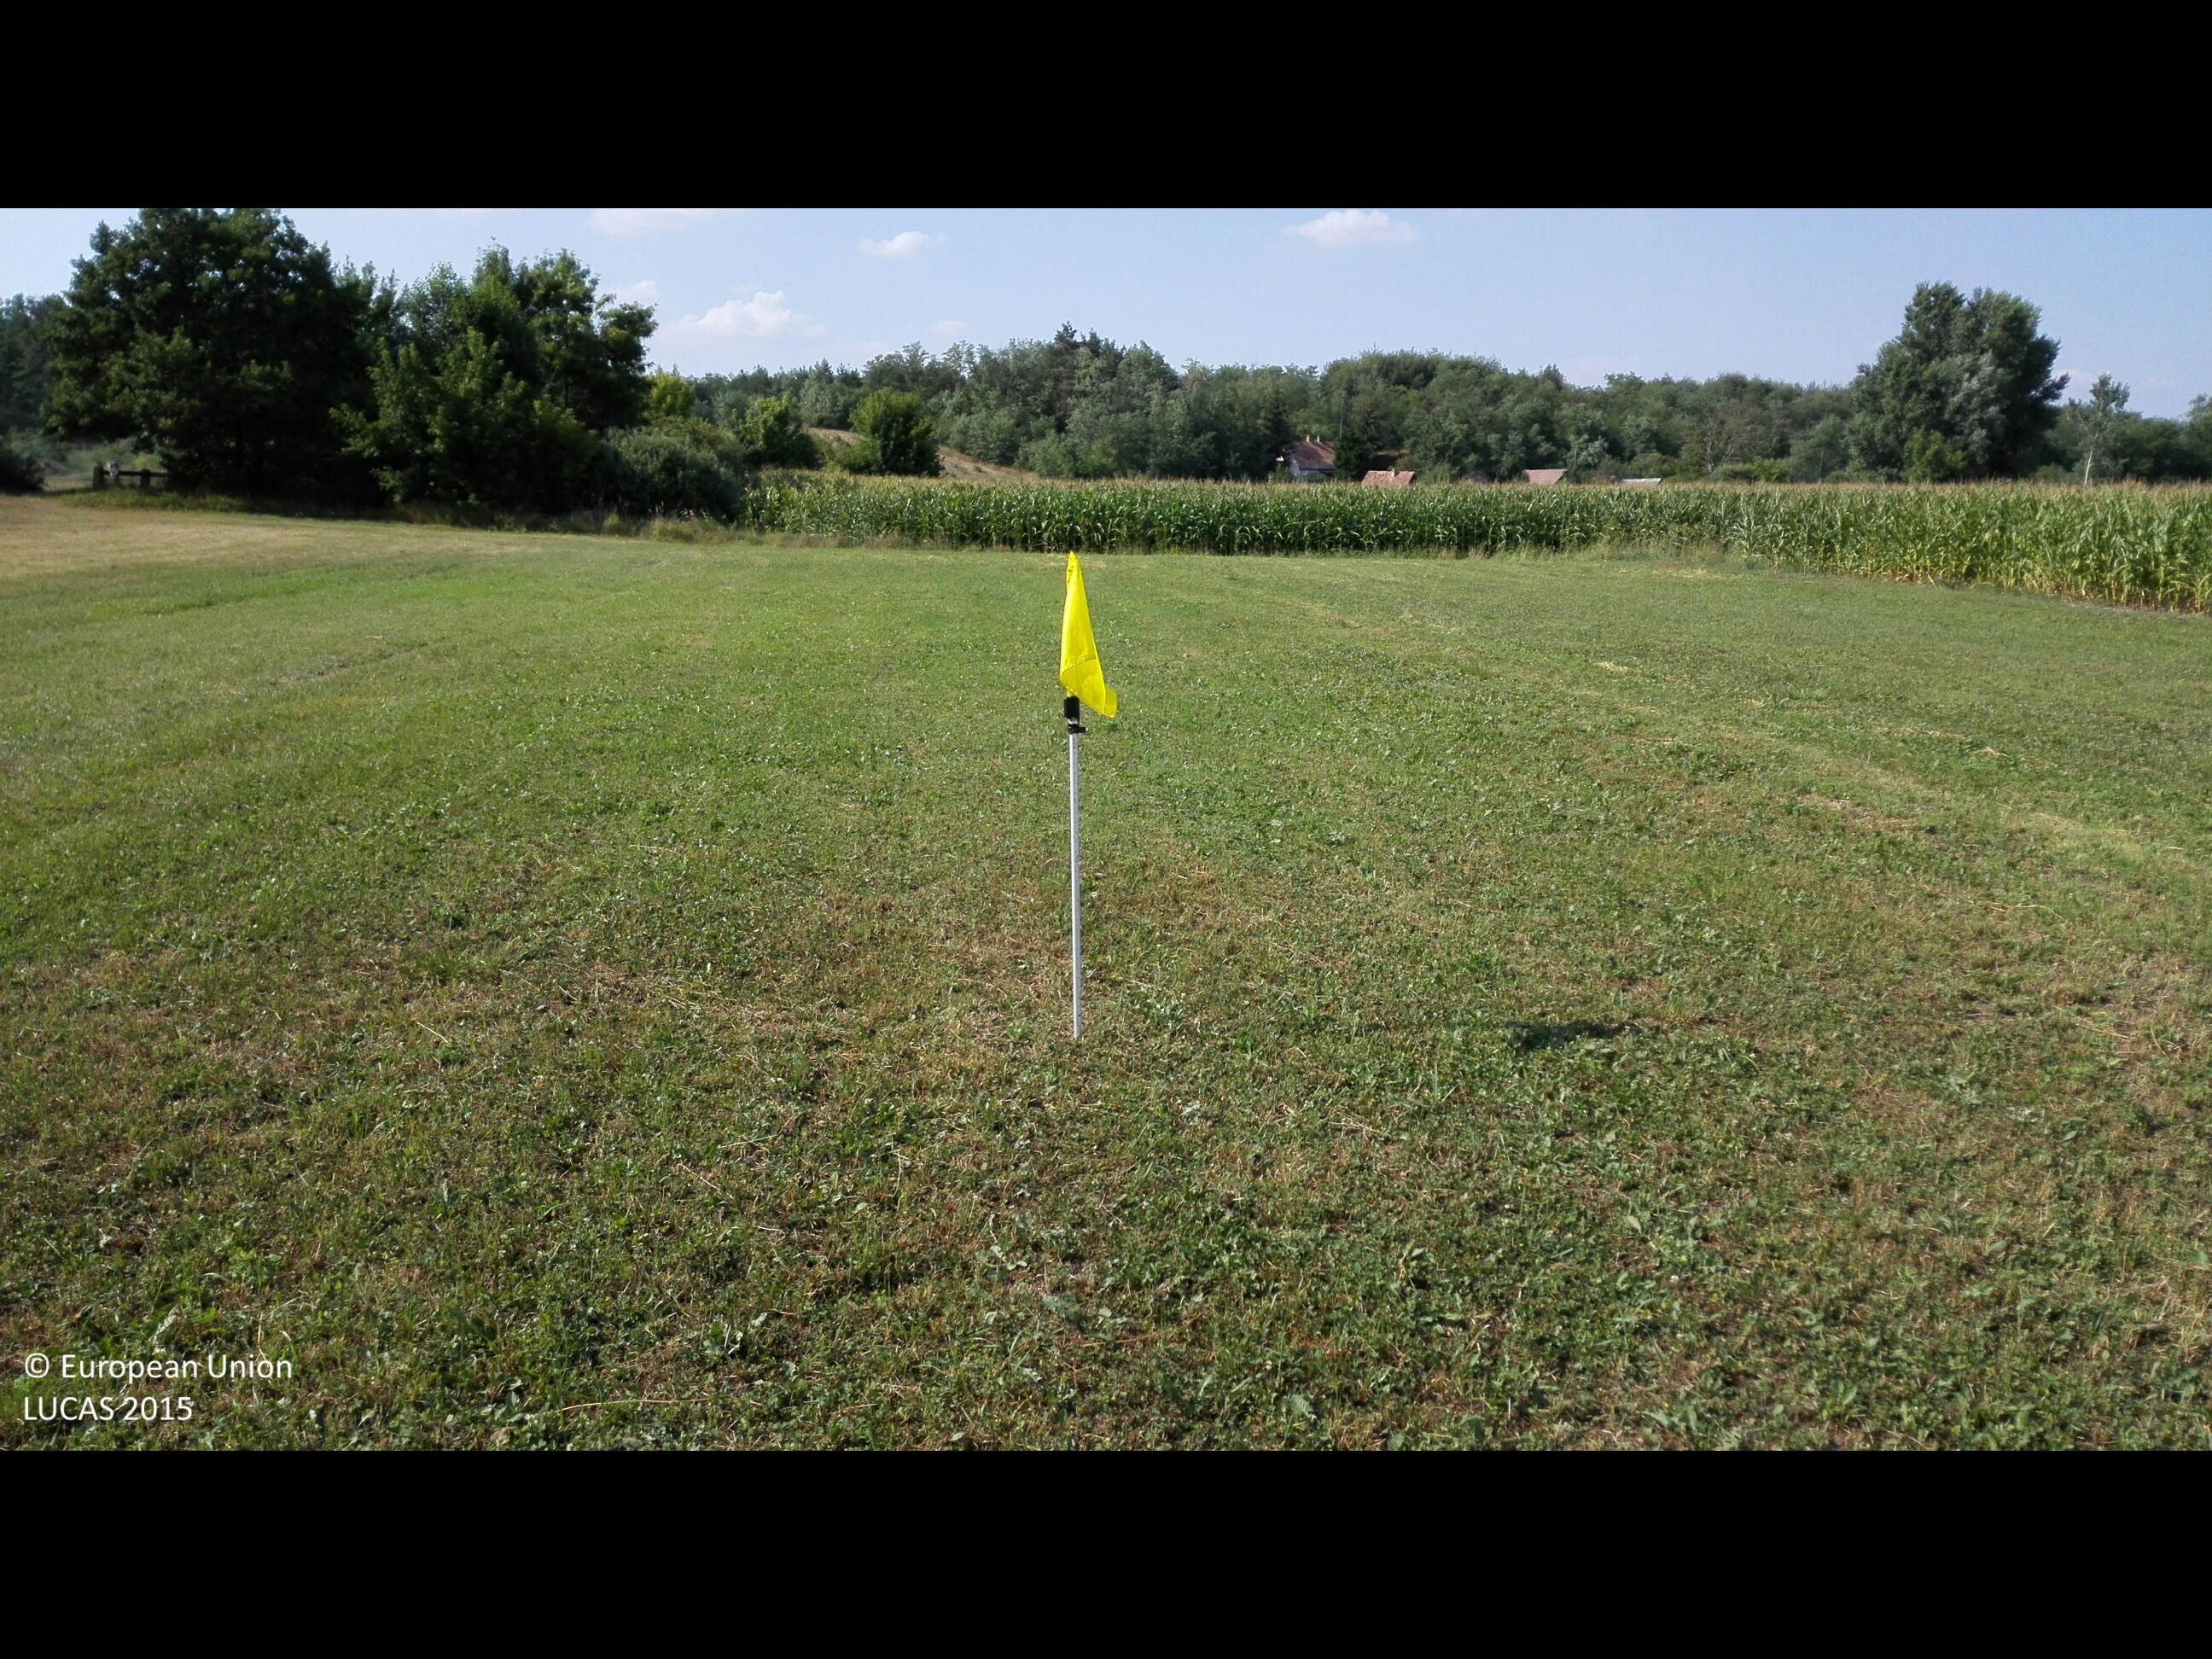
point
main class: Cropland
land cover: Lucerne
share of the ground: > 75 %
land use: Agriculture (excluding fallow land and kitchen gardens)
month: August
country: HU
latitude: 47.5089
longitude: 21.8512
